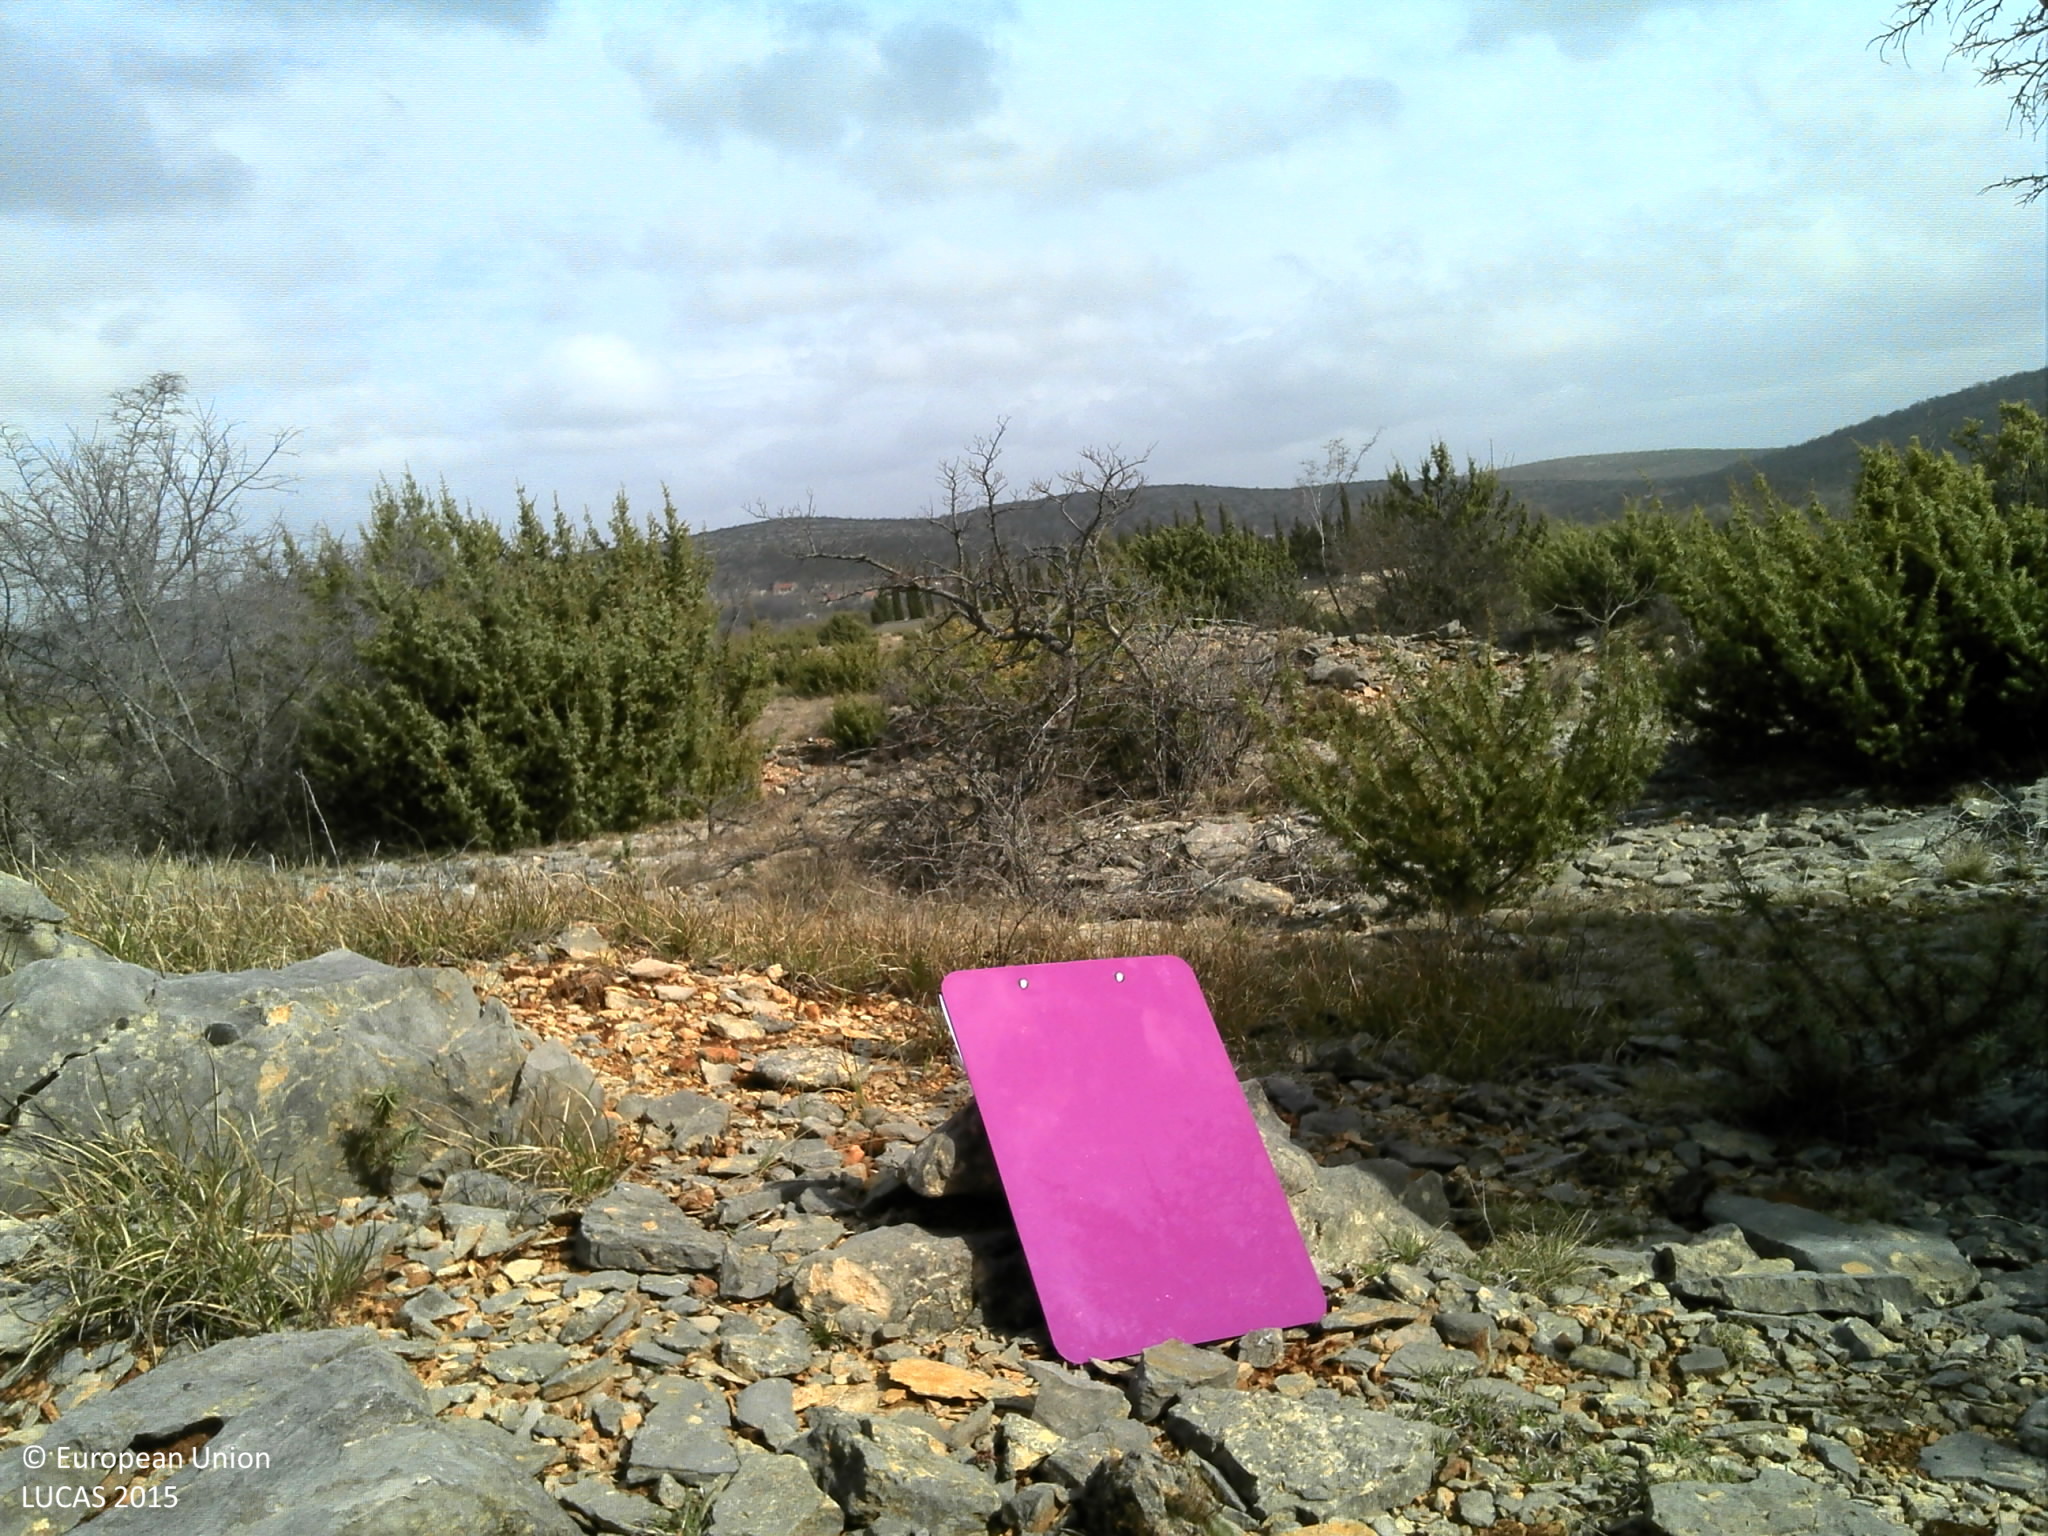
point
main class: Shrubland
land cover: Shrubland with sparse tree cover
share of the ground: 25 - 50 %
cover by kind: shrubs 30 %, unconsolidated bare surface 30 %, consolidated bare surface 10 %, broadleaved forest trees 5 %
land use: Semi-natural and natural areas not in use
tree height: < 5 m
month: March
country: HR
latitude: 43.9678
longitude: 15.8625
